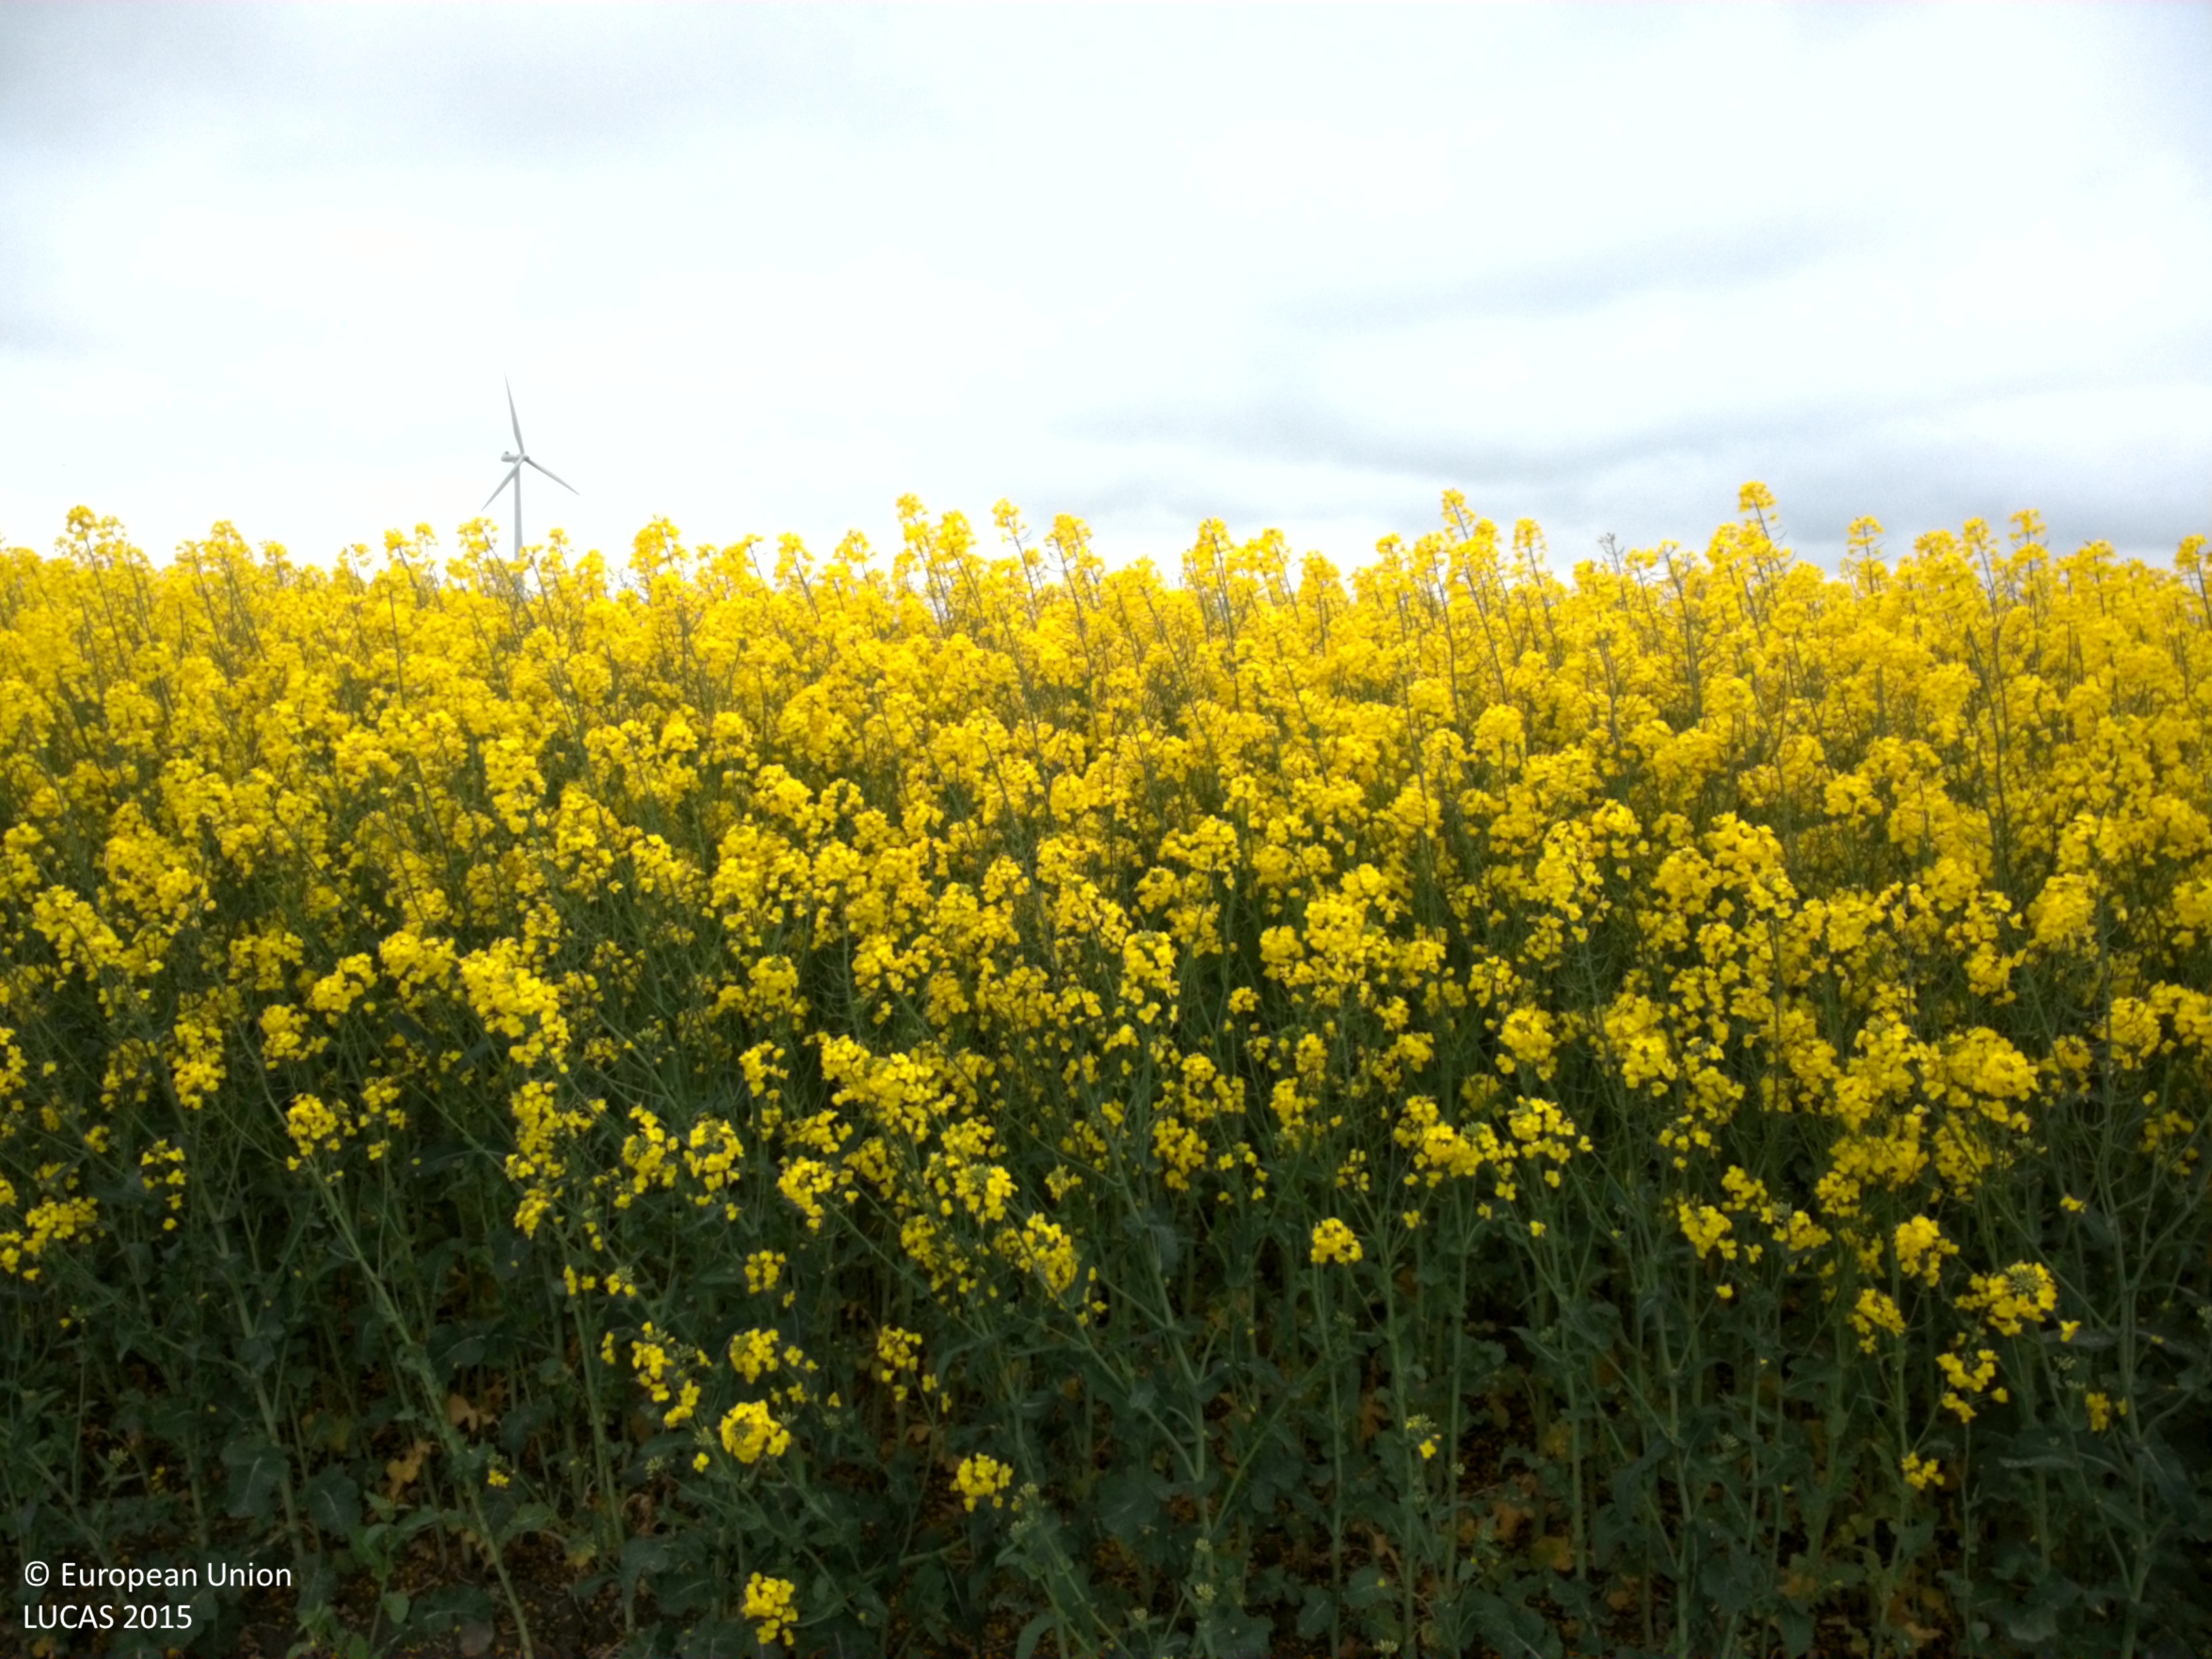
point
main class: Cropland
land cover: Rape and turnip rape
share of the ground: > 75 %
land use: Agriculture (excluding fallow land and kitchen gardens)
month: May
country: SE
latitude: 55.7537
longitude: 13.1367
